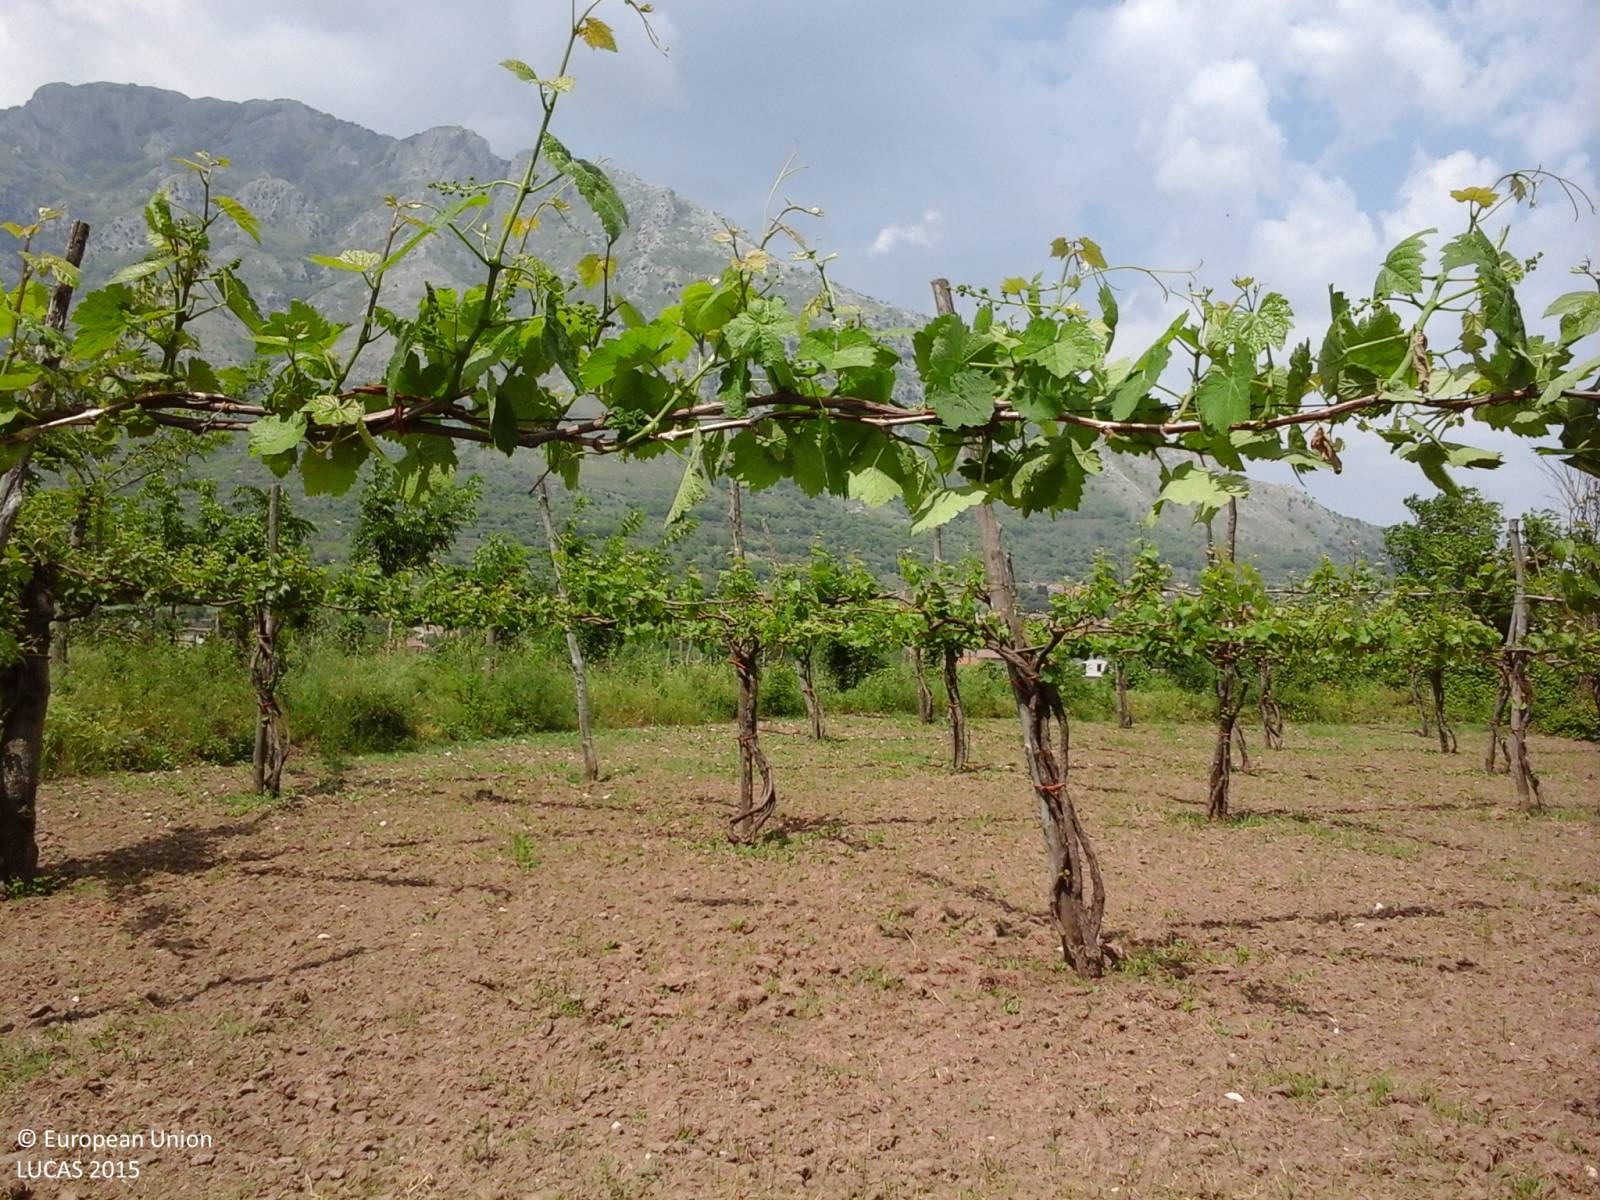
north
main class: Cropland
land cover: Vineyards
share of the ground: 50 - 75 %
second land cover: Other bare soil
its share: > 75 %
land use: Agriculture (excluding fallow land and kitchen gardens)
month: May
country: IT
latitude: 41.0649
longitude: 14.6112
